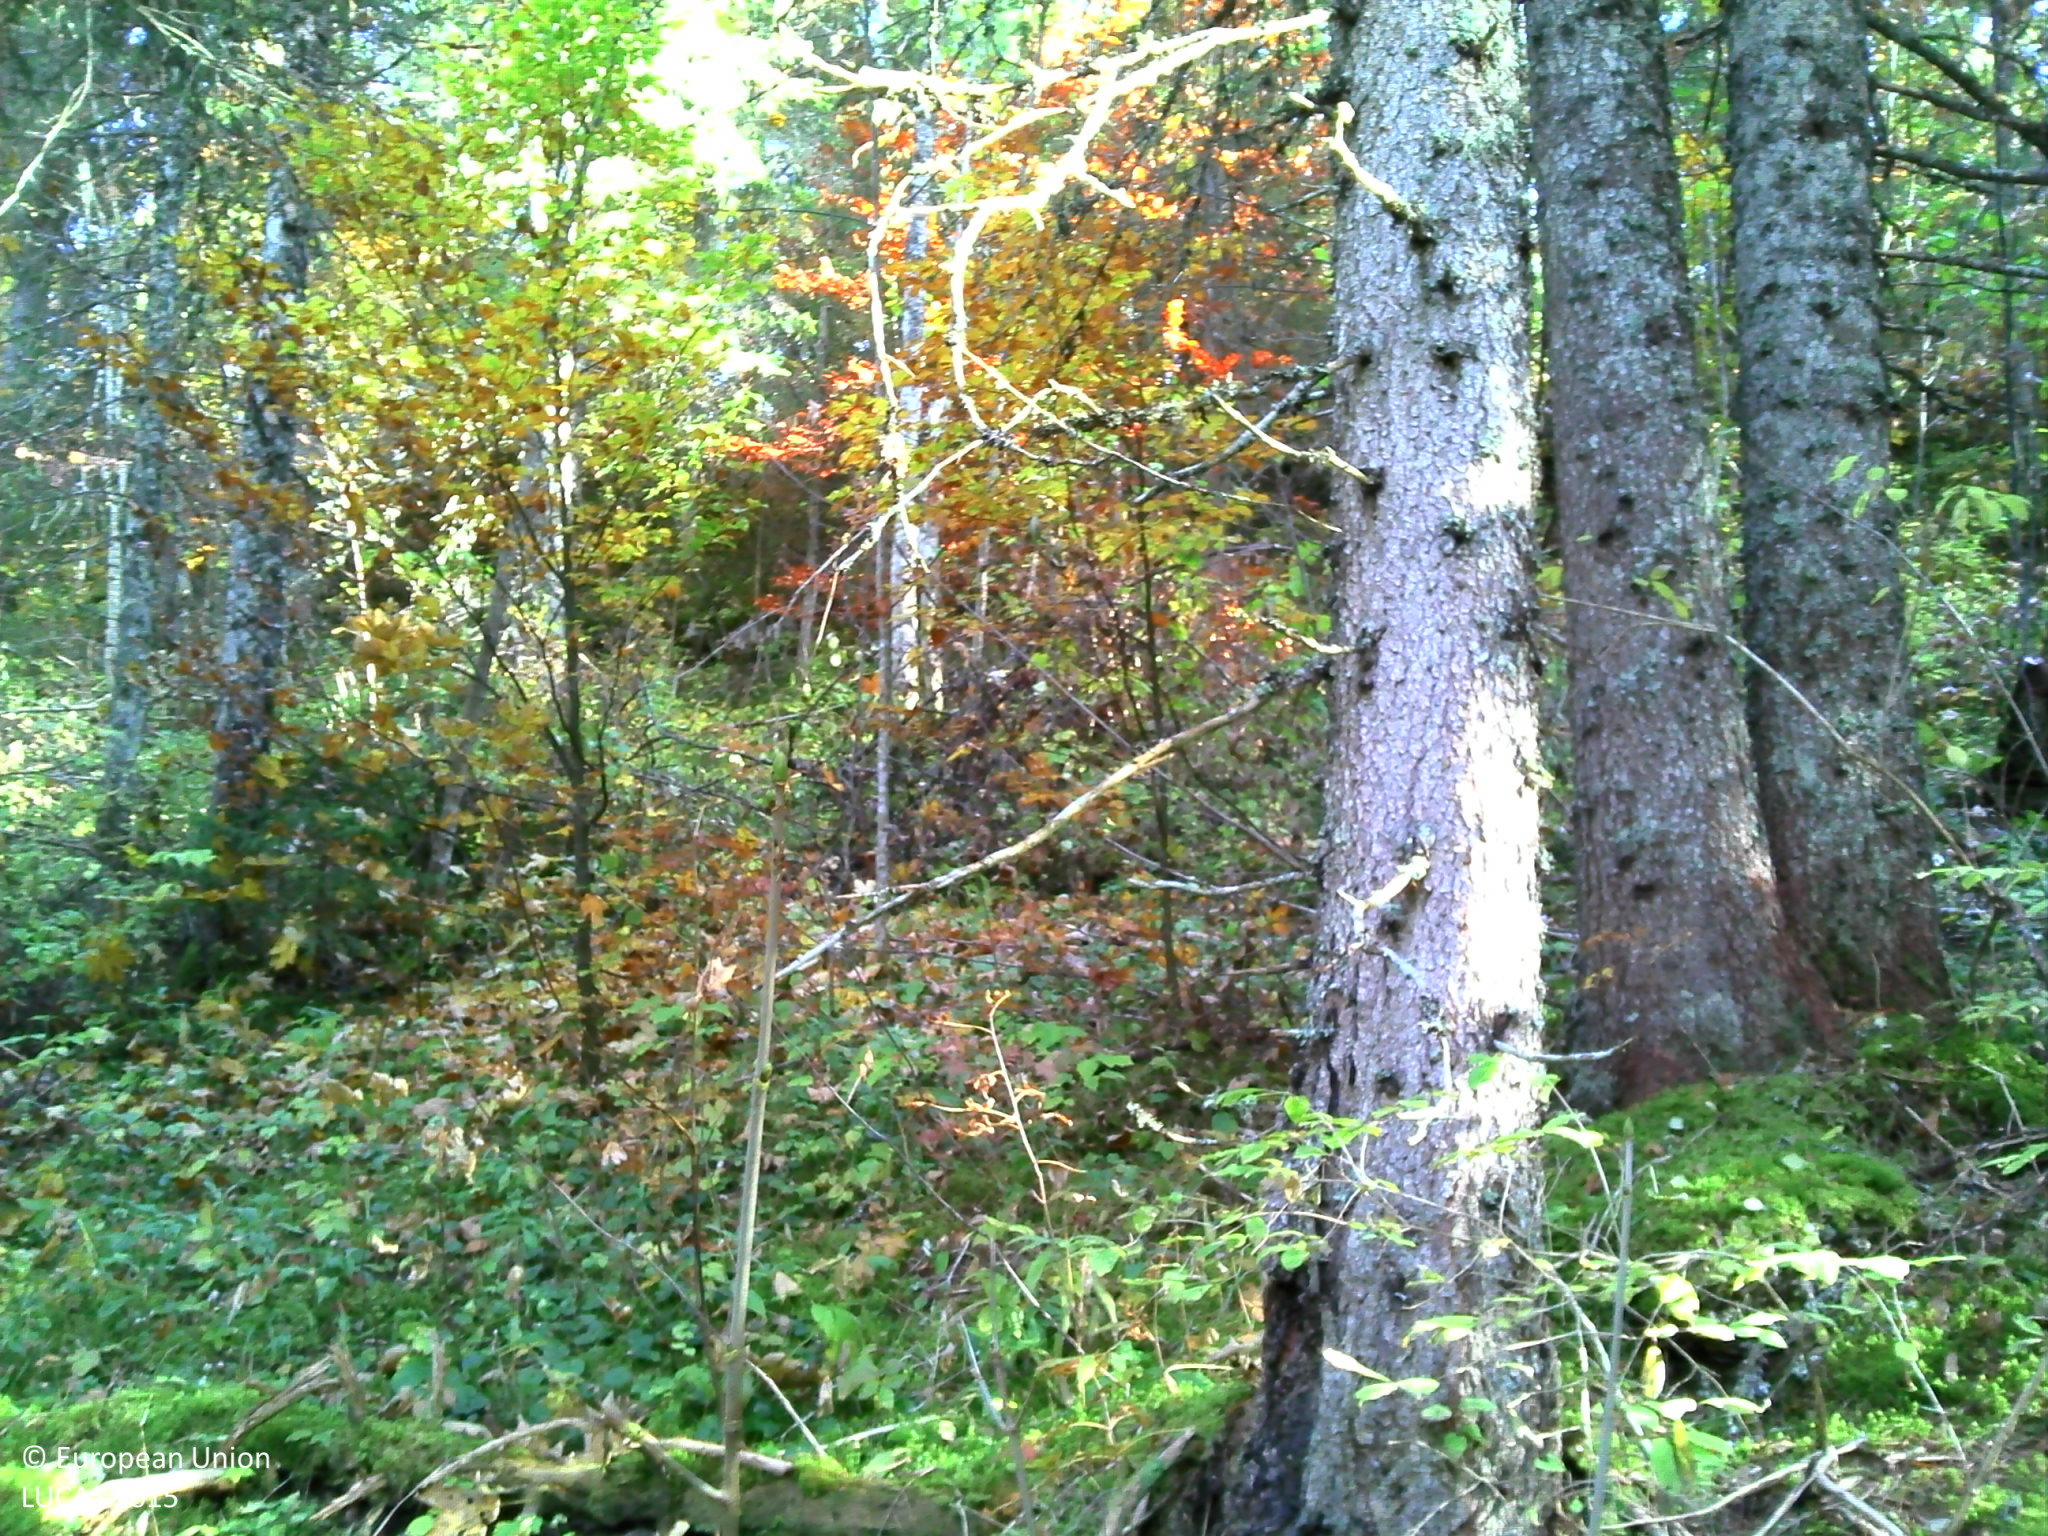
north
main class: Woodland
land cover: Spruce dominated coniferous woodland
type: hemiboreal forest and nemoral coniferous forest and mixed broadleaved-coniferous forest
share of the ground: > 75 %
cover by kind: coniferous forest trees 75 %, shrubs 10 %, herbaceous plants 10 %, broadleaved forest trees 5 %
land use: Forestry
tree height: > 5 m
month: October
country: FR
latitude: 46.6037
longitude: 6.0732
